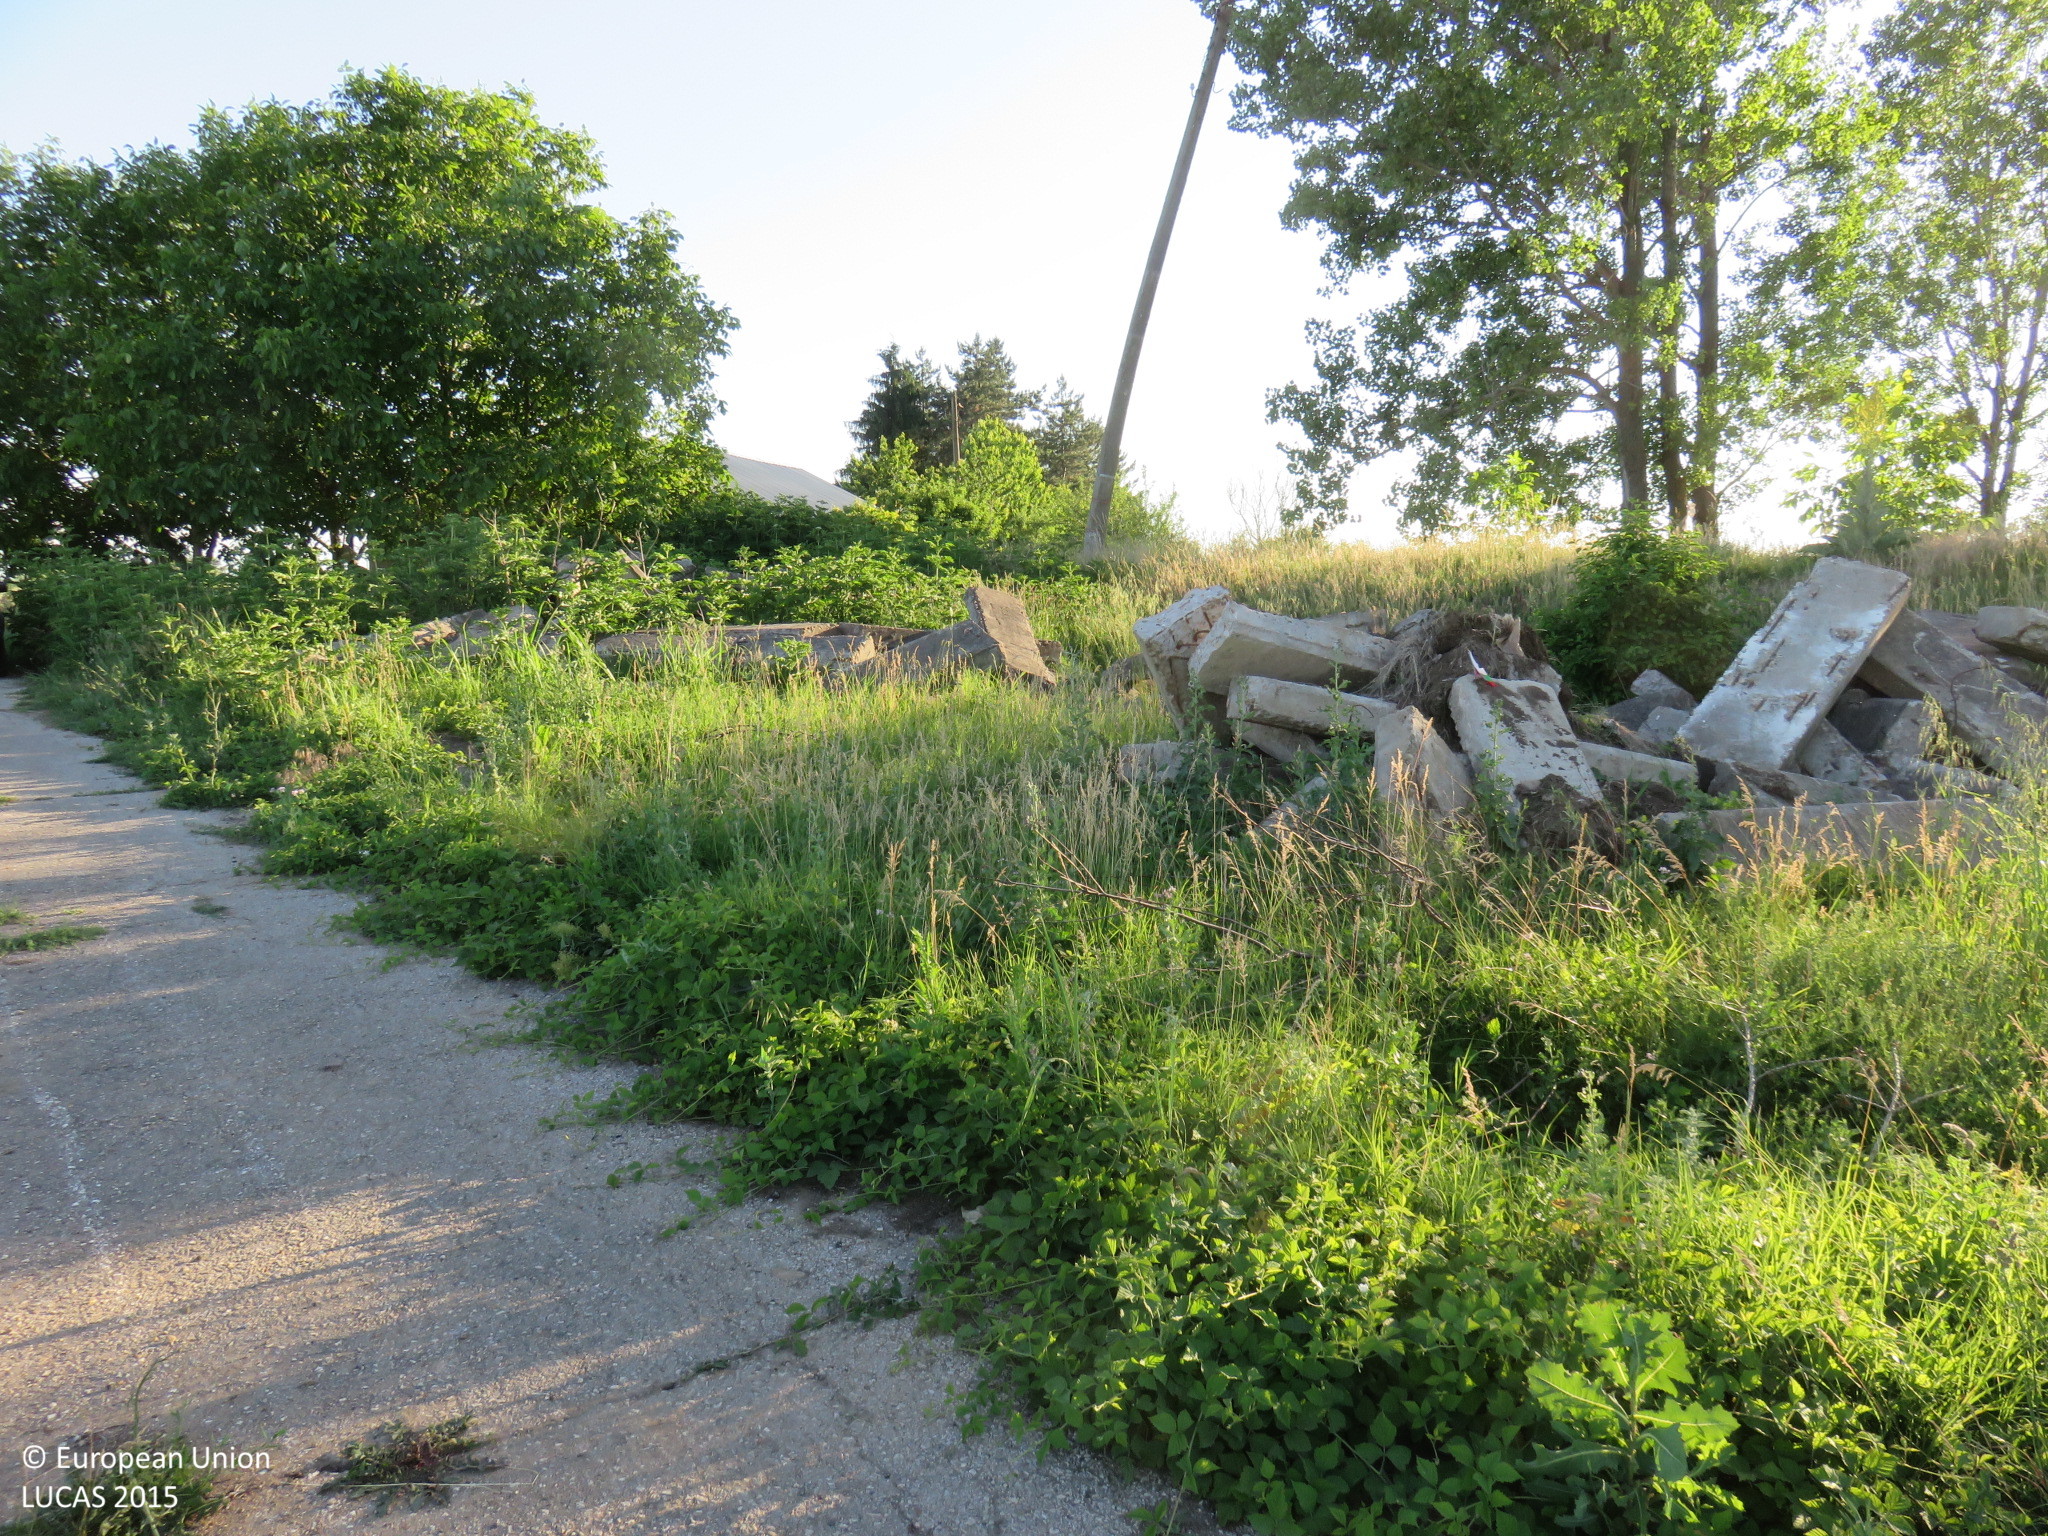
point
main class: Grassland
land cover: Grassland with sparse tree/shrub cover
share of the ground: 50 - 75 %
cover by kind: herbaceous plants 90 %, broadleaved forest trees 5 %, shrubs 5 %
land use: Semi-natural and natural areas not in use
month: June
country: BG
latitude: 43.3572
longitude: 24.4081
